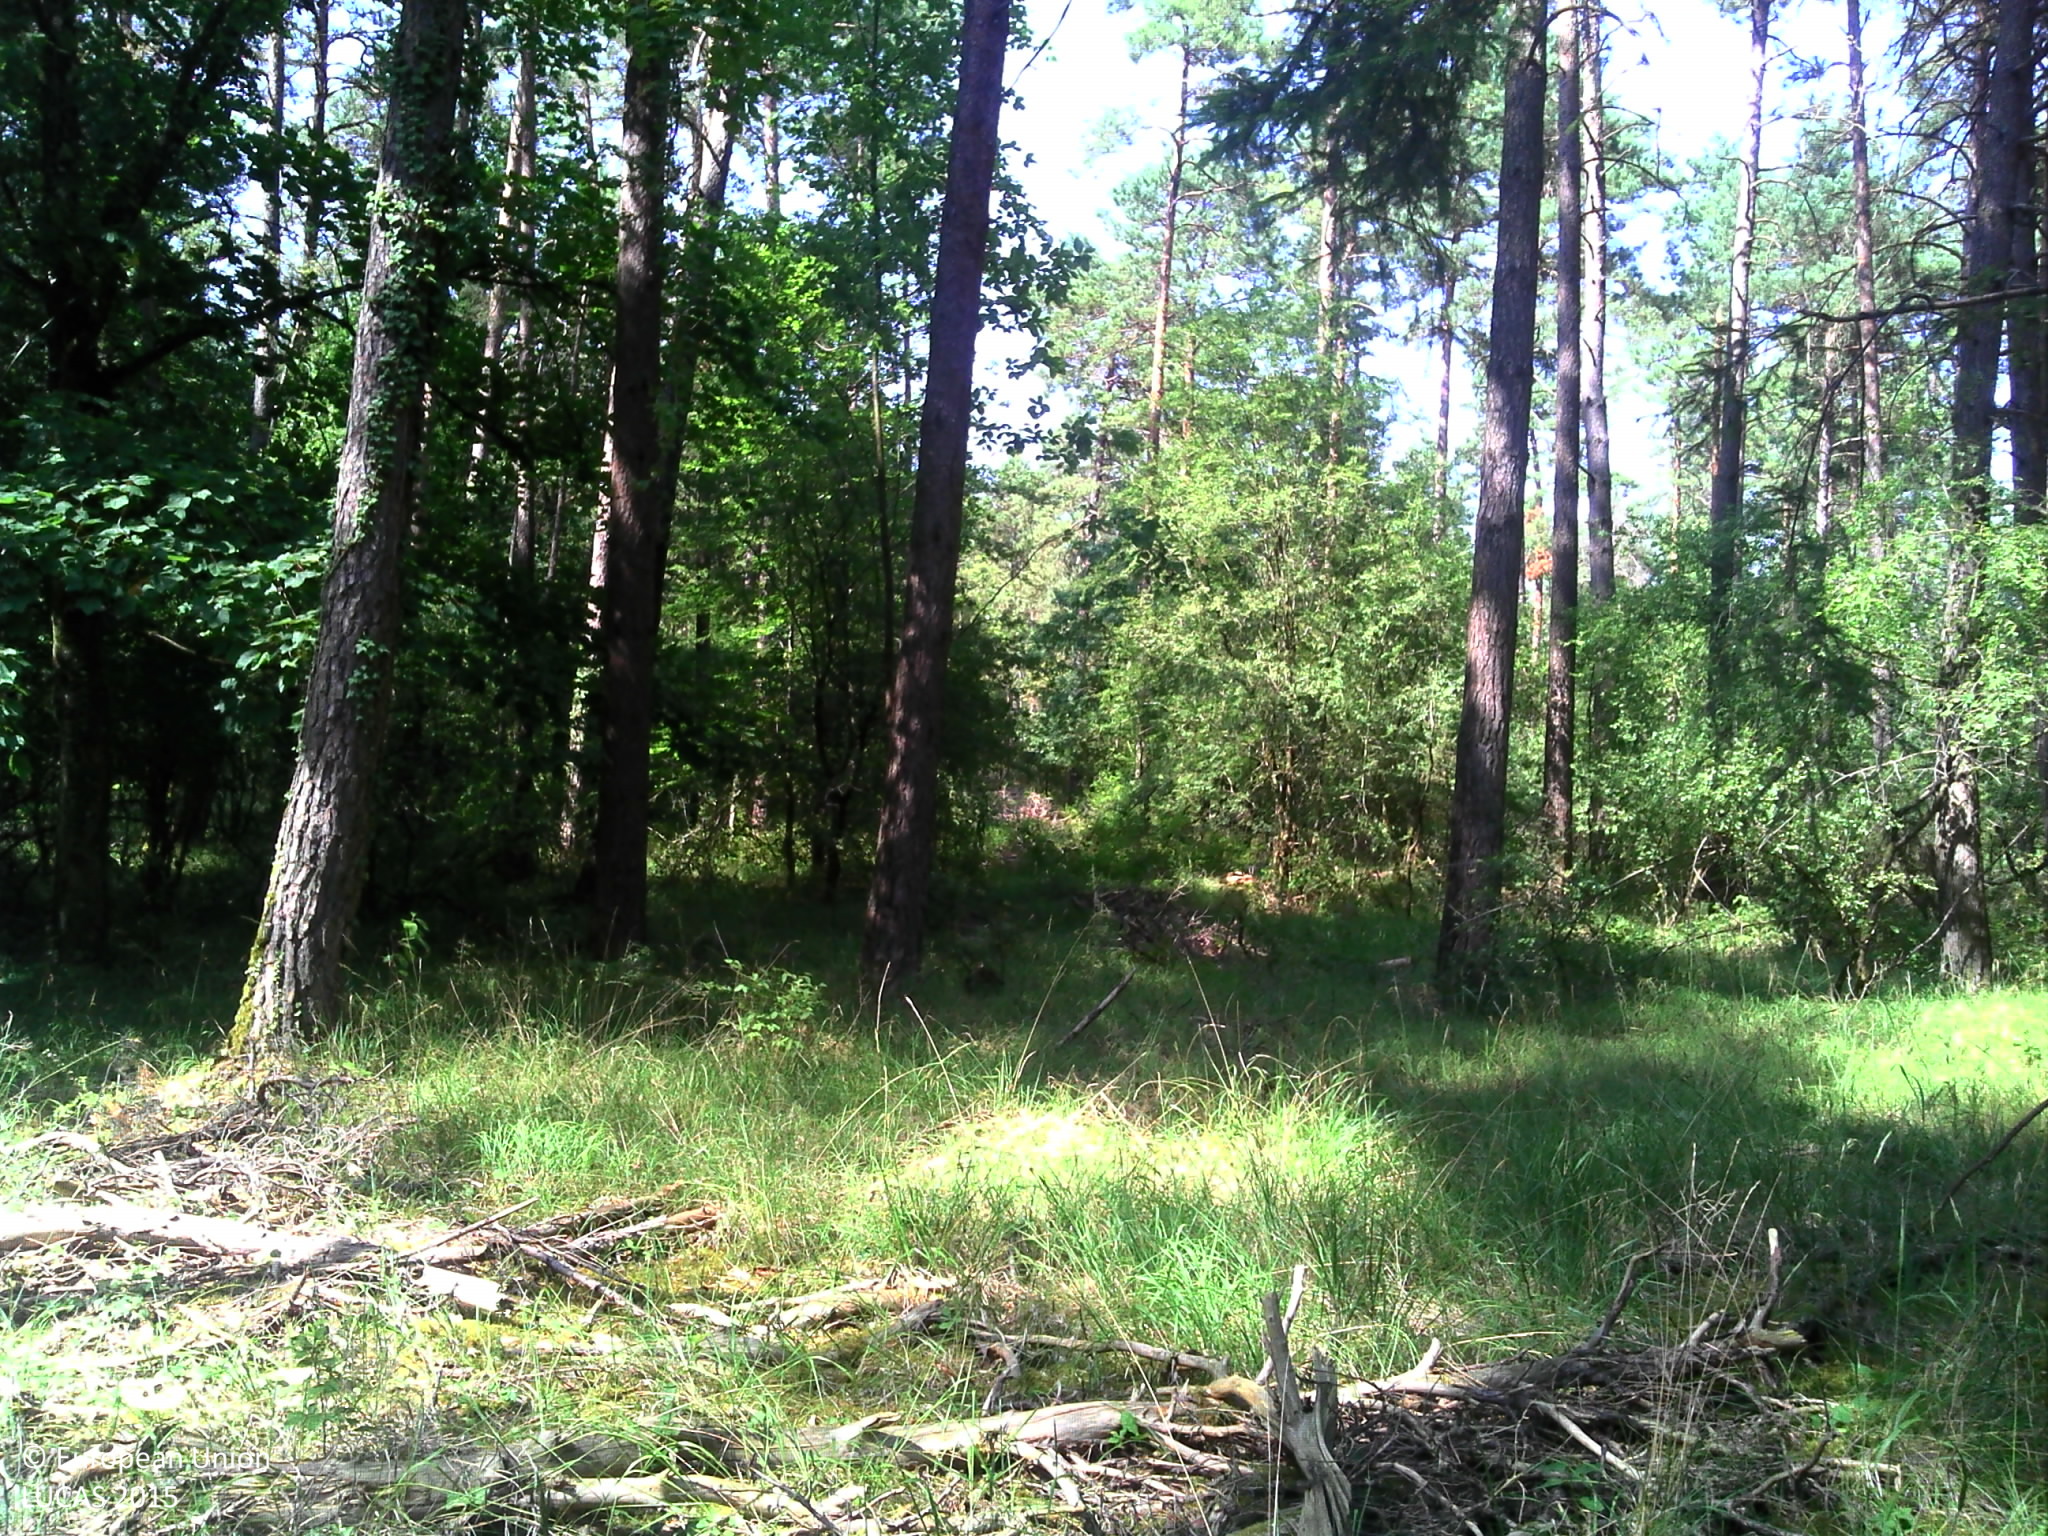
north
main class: Woodland
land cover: Spruce dominated coniferous woodland
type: alpine coniferous forest
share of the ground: > 75 %
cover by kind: coniferous forest trees 60 %, broadleaved forest trees 20 %, herbaceous plants 10 %, lichens and mosses 10 %
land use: Forestry
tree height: > 5 m
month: July
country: FR
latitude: 48.0805
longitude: 4.7499
